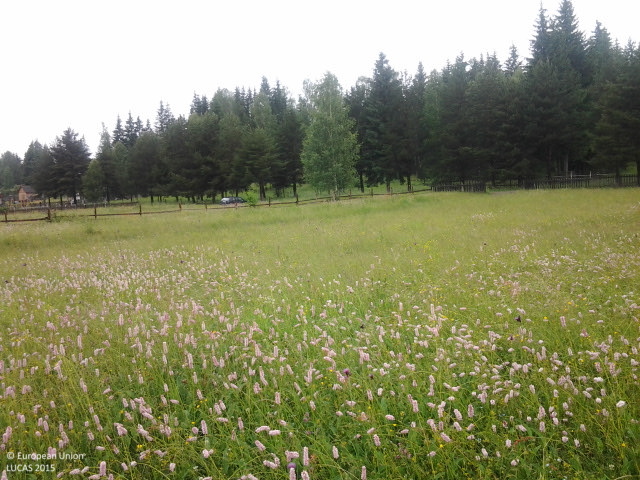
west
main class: Grassland
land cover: Grassland without tree/shrub cover
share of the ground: > 75 %
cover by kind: herbaceous plants 100 %
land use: Agriculture (excluding fallow land and kitchen gardens)
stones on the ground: < 10 %
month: June
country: RO
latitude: 47.2507
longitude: 25.3452
